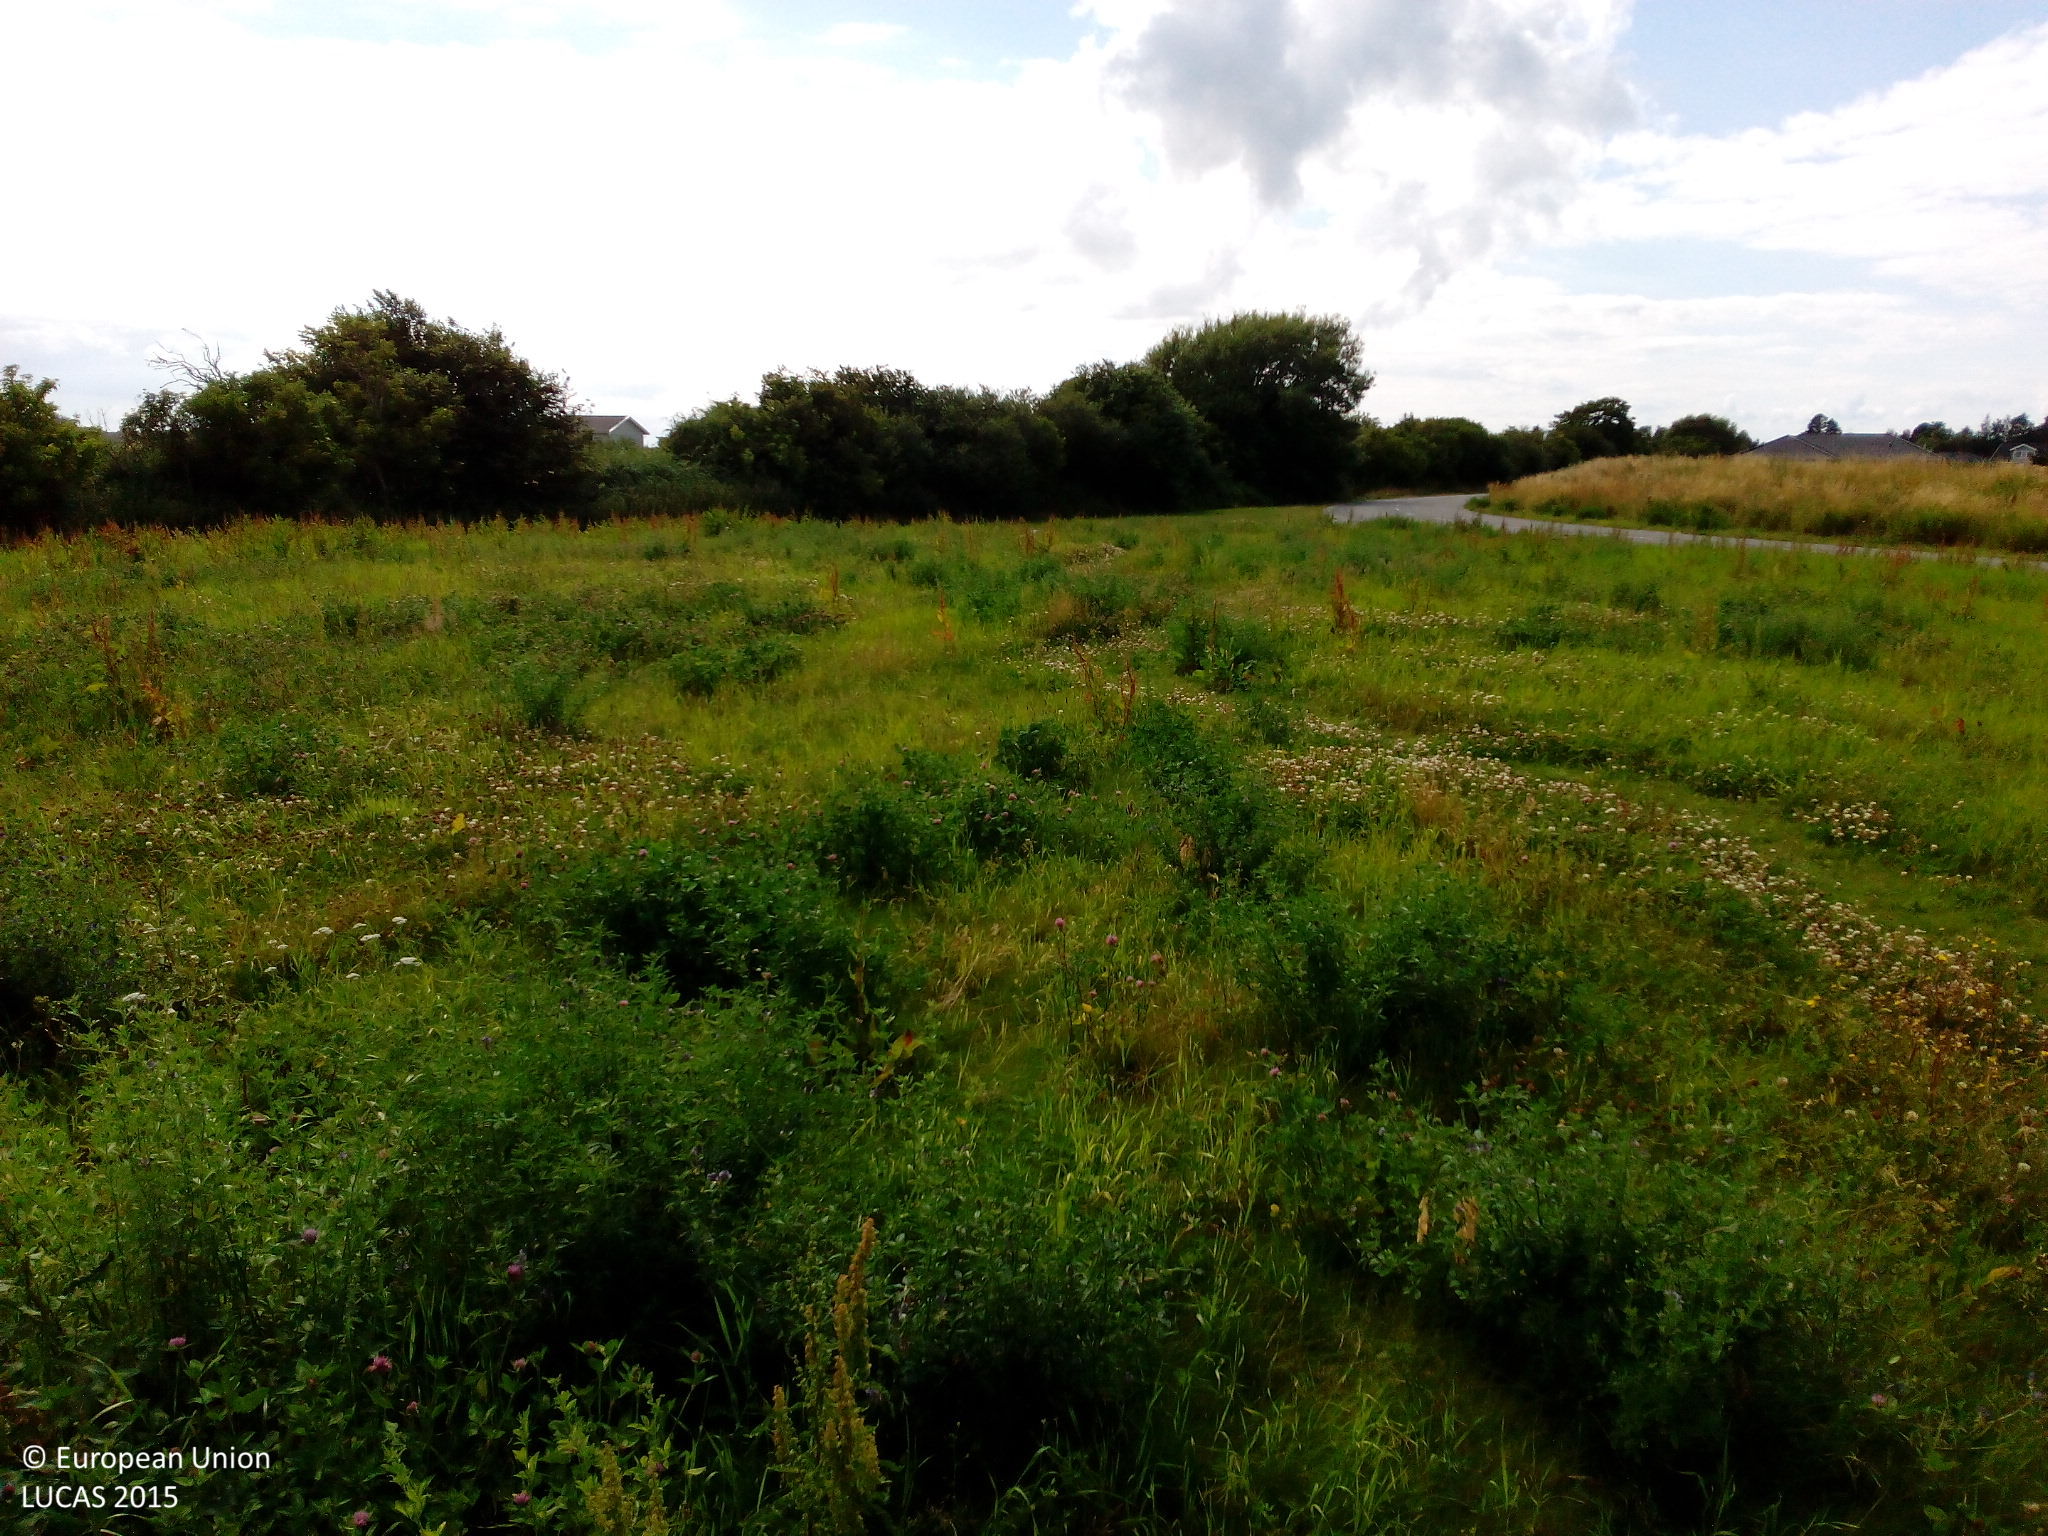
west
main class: Grassland
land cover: Grassland without tree/shrub cover
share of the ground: > 75 %
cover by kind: herbaceous plants 100 %
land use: Amenities, museums, leisure
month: July
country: DK
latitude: 55.7495
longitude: 11.3210
